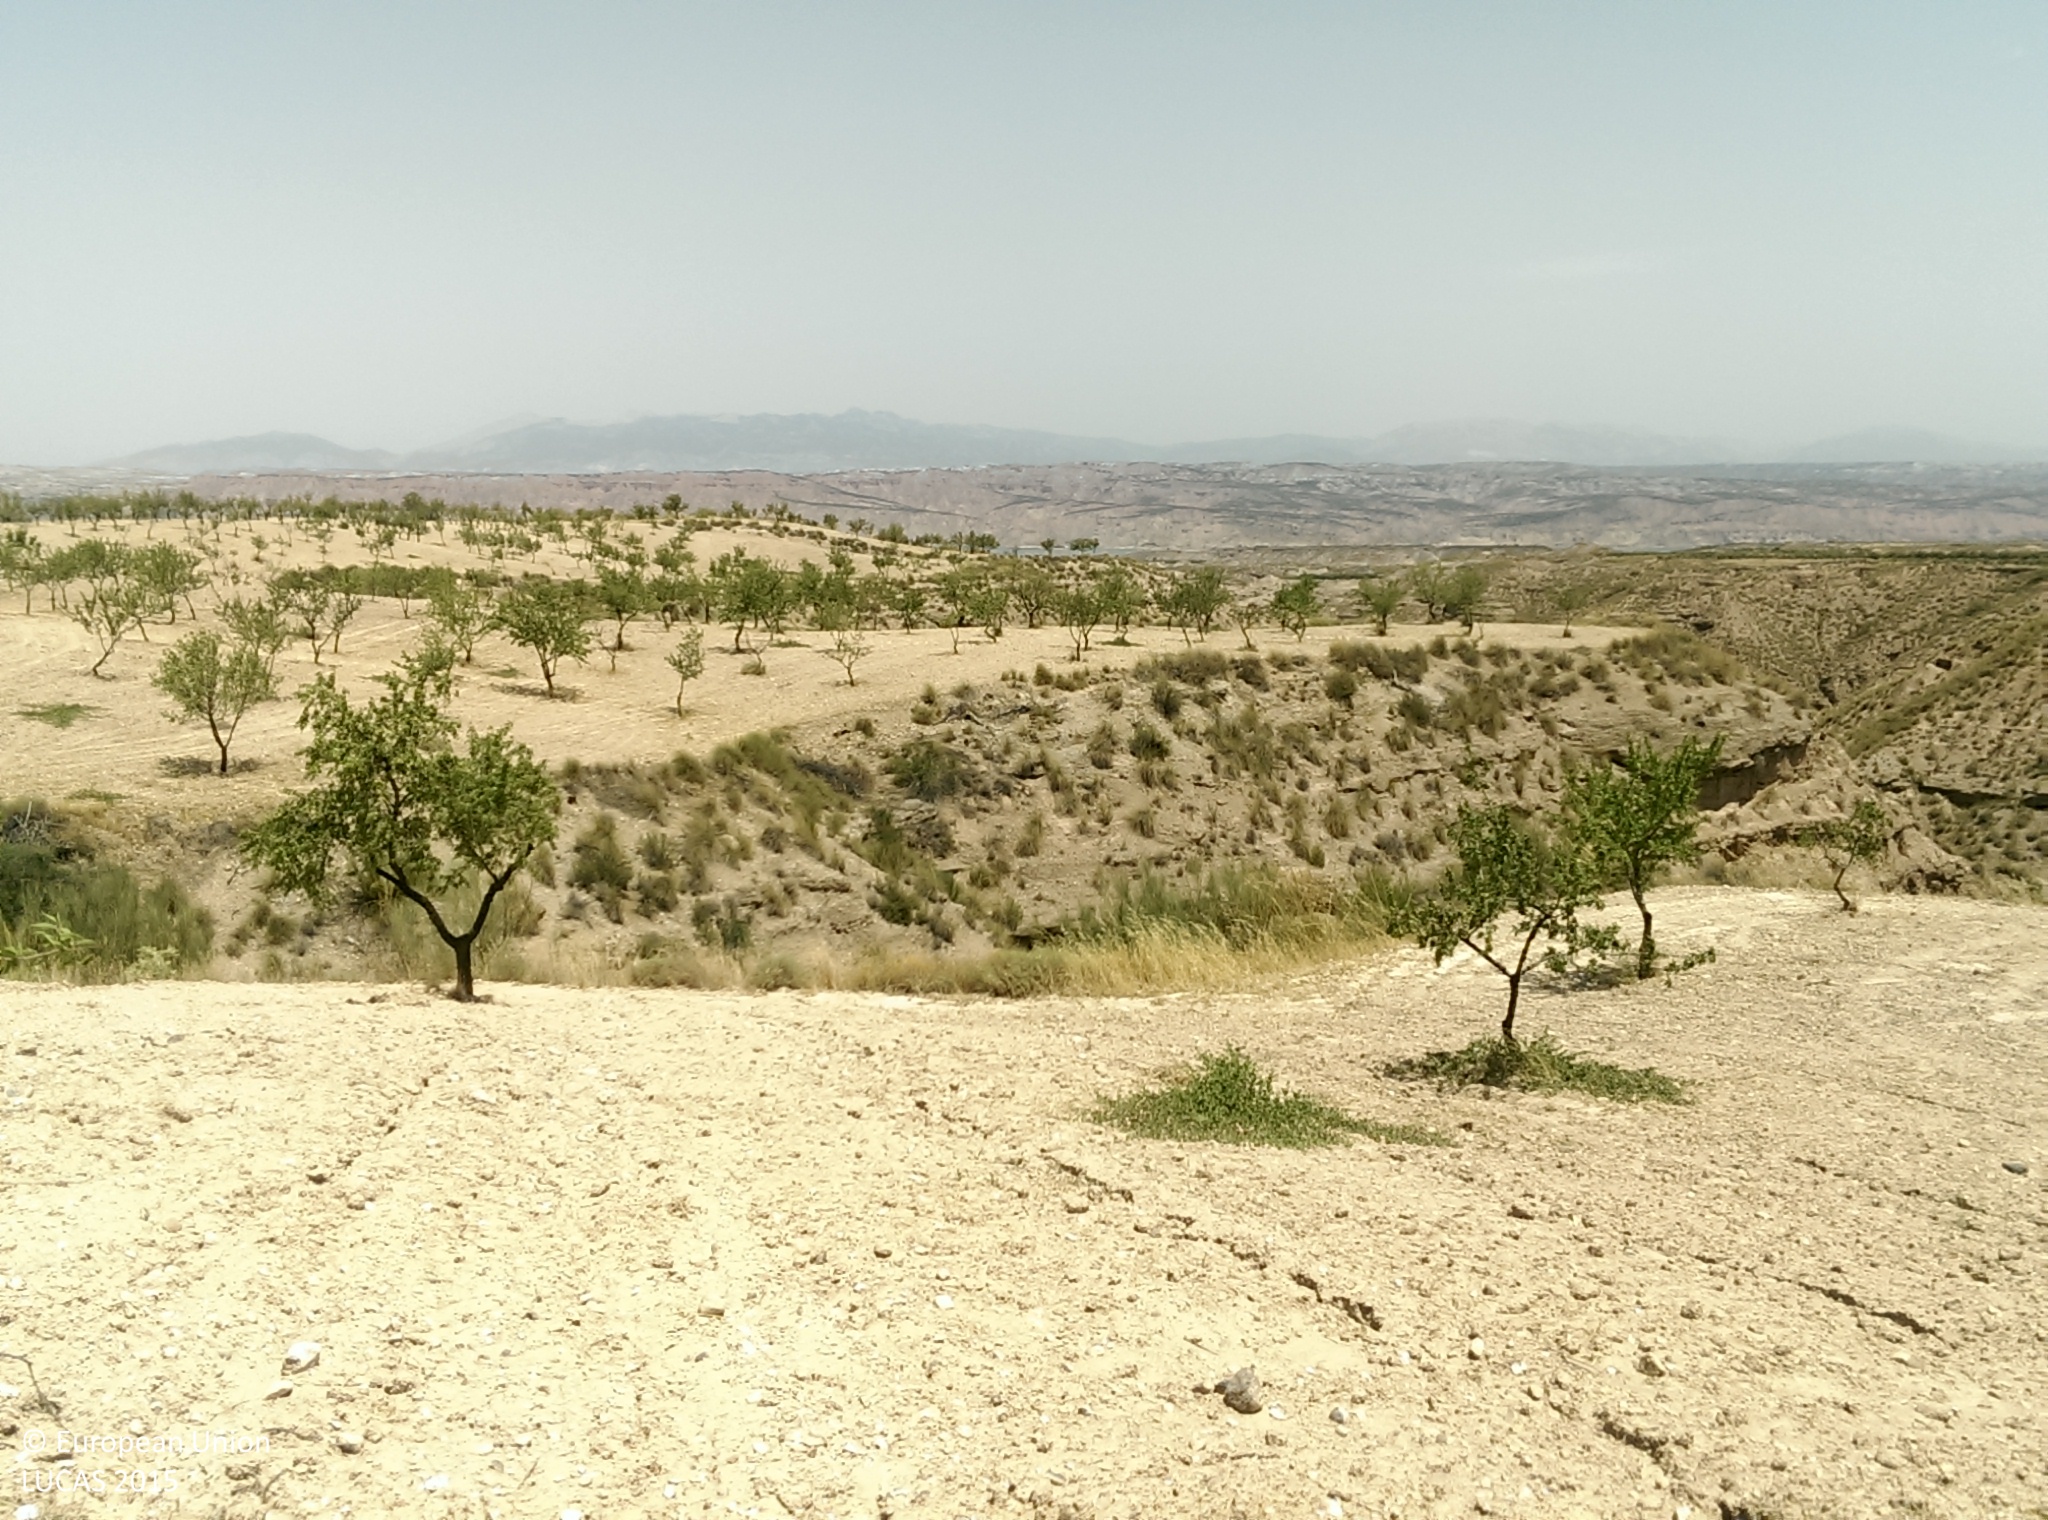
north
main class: Cropland
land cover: Nuts trees
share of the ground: < 10 %
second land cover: Other bare soil
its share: > 75 %
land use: Agriculture (excluding fallow land and kitchen gardens)
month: July
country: ES
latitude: 37.5222
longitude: -2.9216
